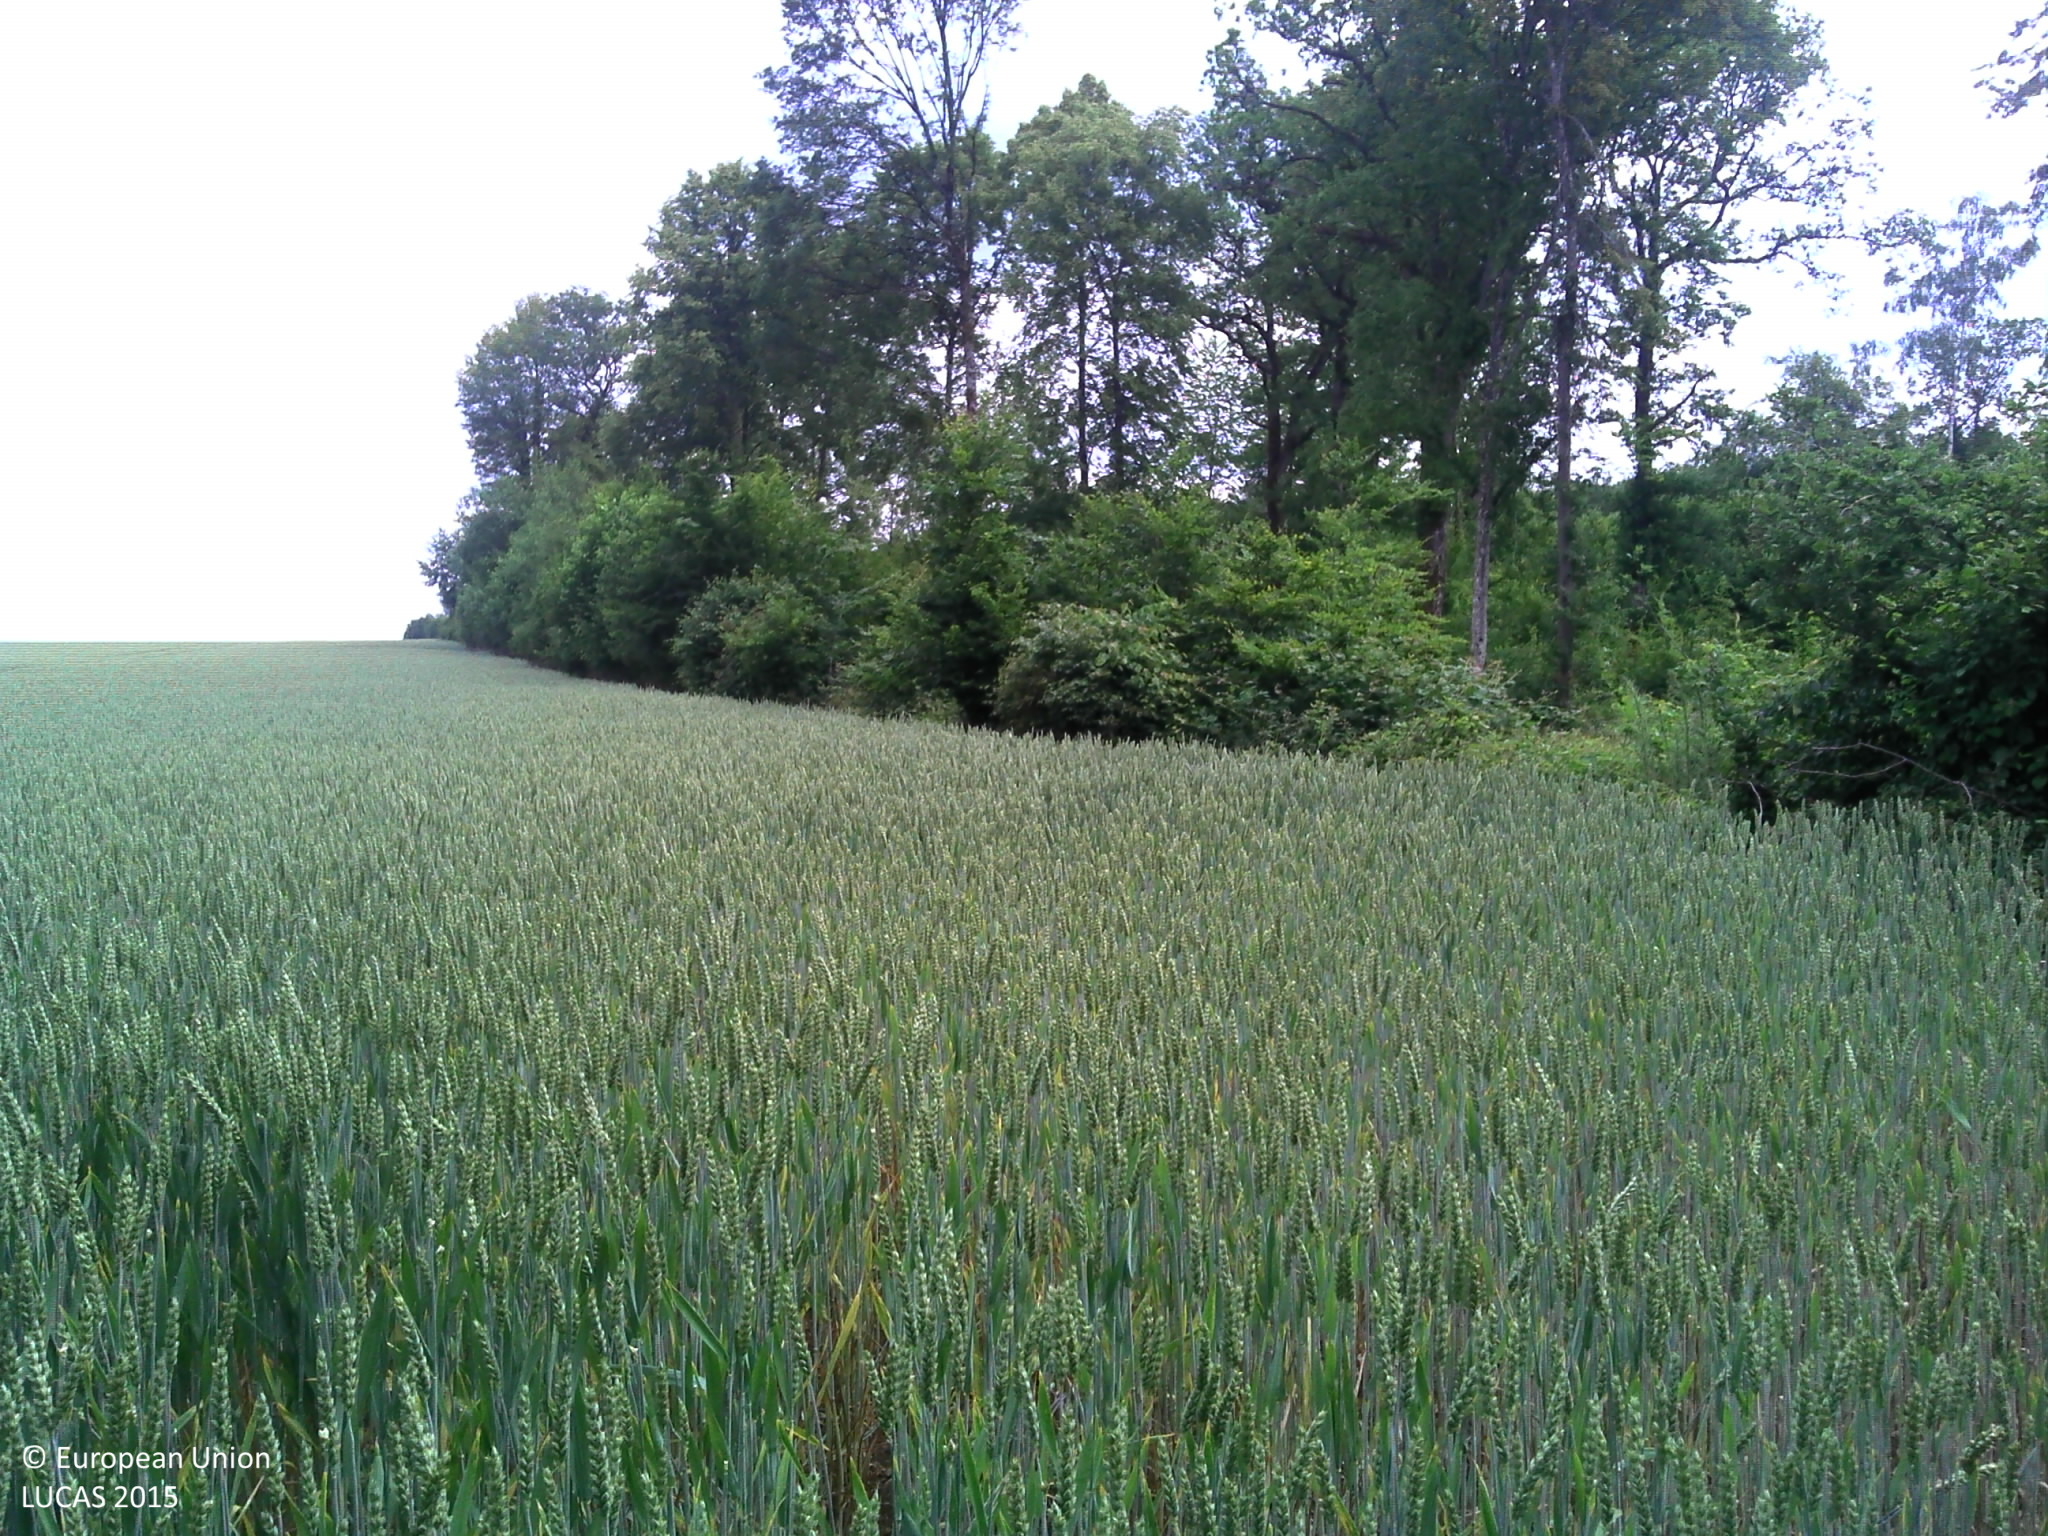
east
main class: Cropland
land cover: Common wheat
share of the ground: > 75 %
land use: Agriculture (excluding fallow land and kitchen gardens)
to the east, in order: Common wheat; Broadleaved woodland
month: June
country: FR
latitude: 48.2449
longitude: 5.1917
